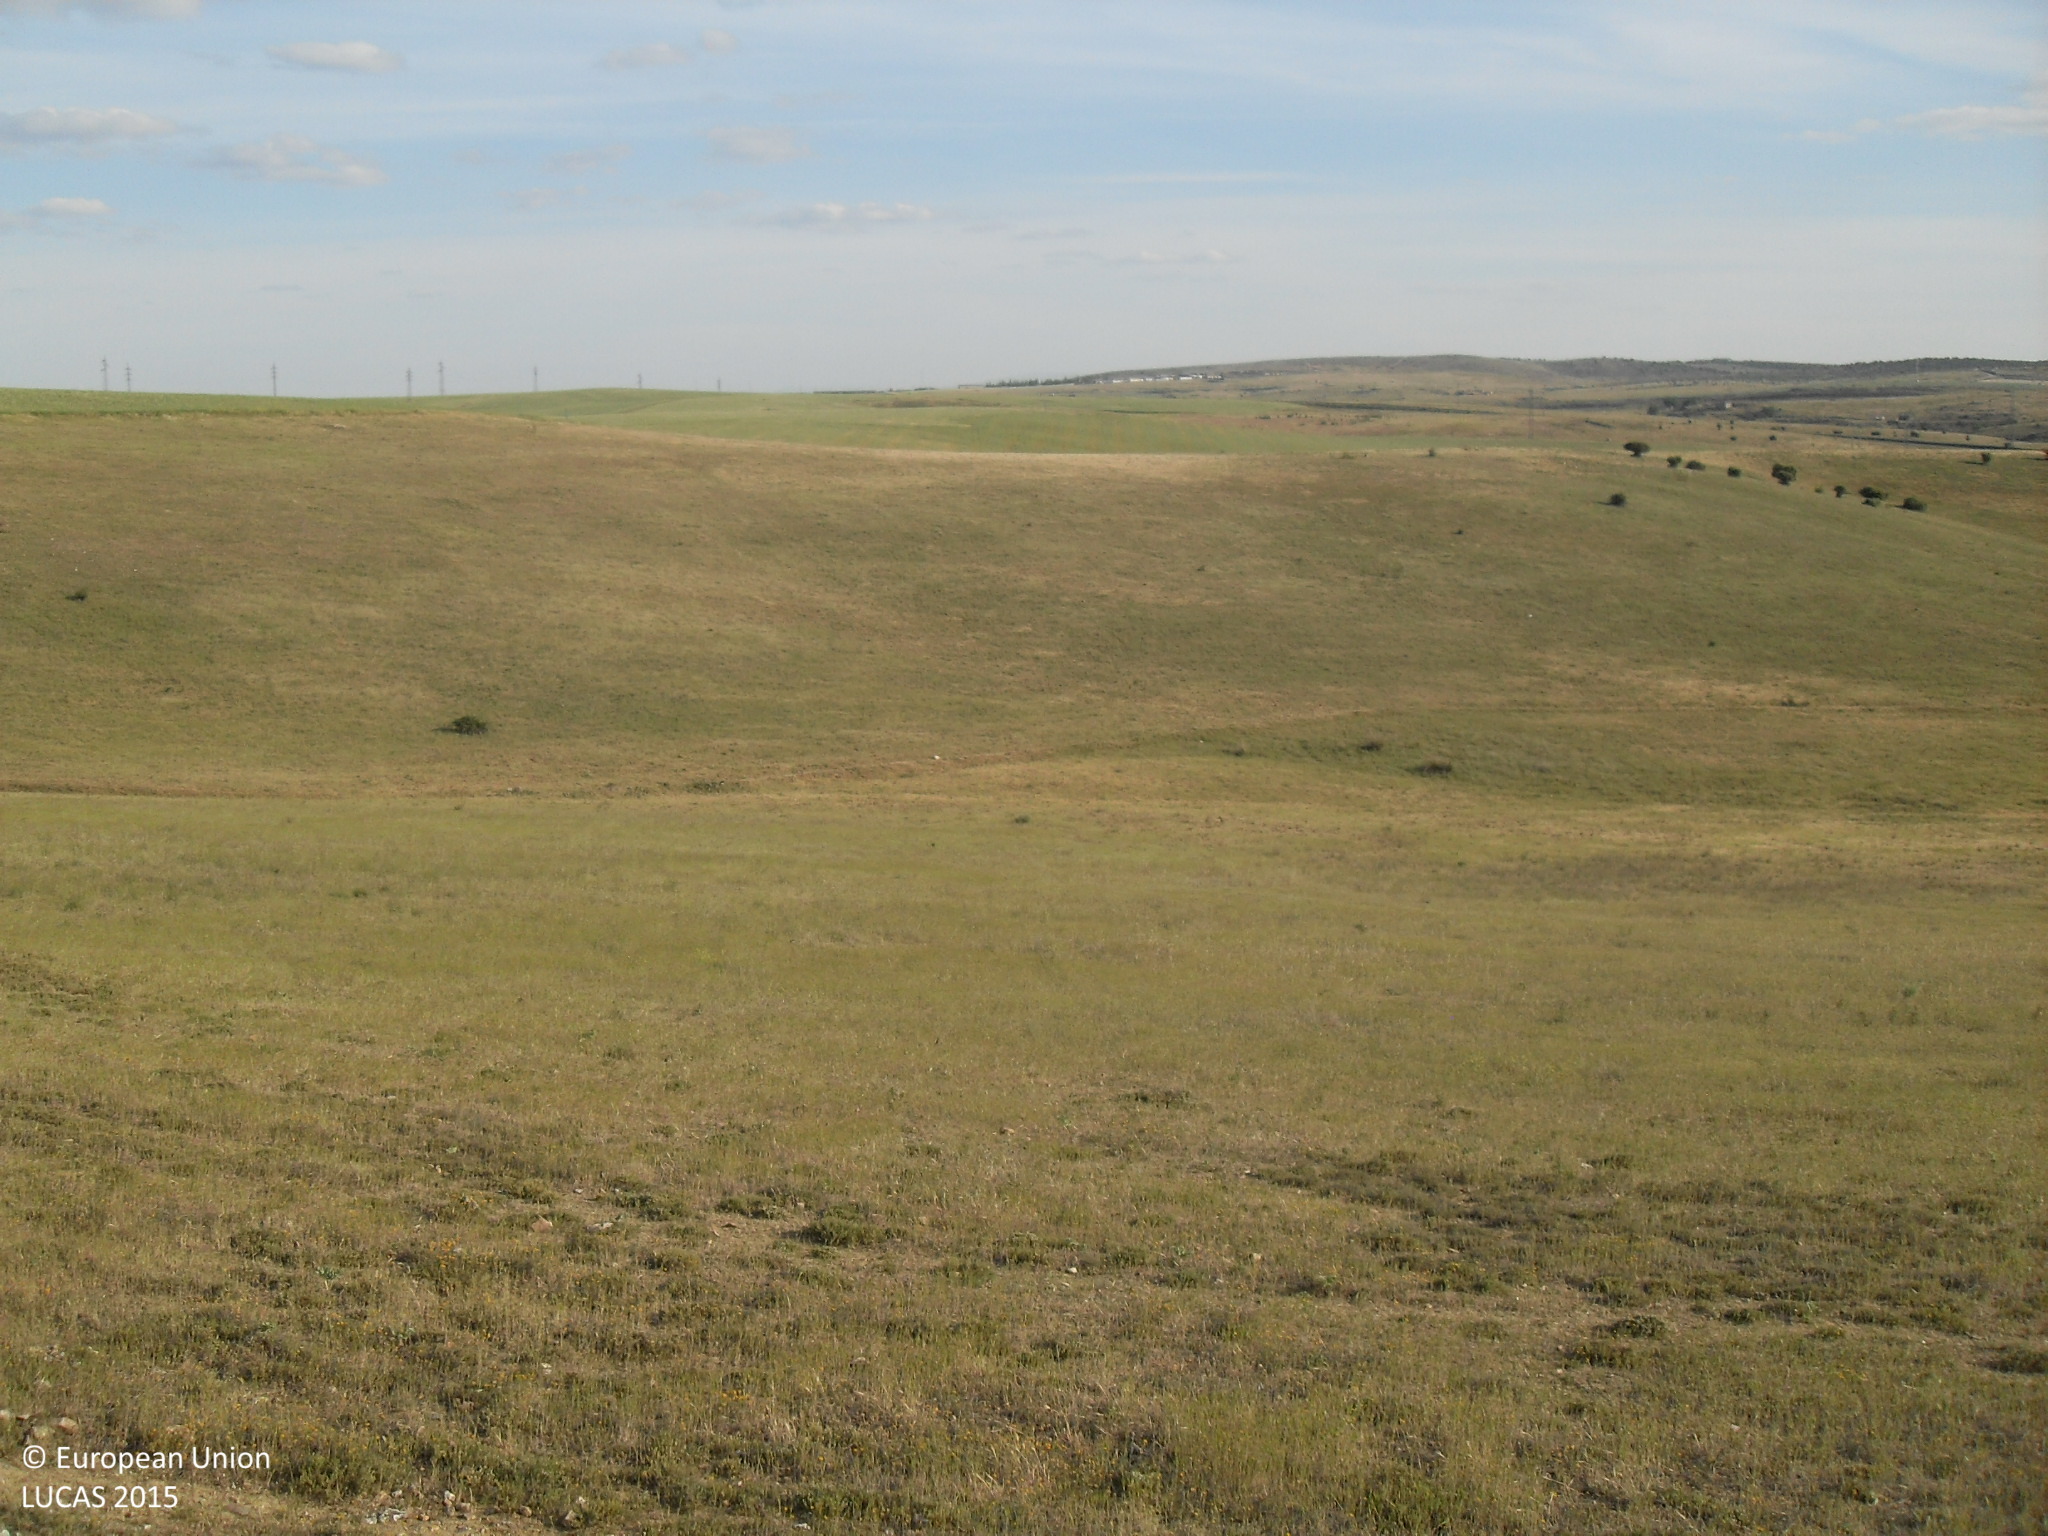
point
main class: Grassland
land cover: Grassland without tree/shrub cover
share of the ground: > 75 %
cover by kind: herbaceous plants 100 %
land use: Agriculture (excluding fallow land and kitchen gardens)
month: May
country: ES
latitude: 40.9788
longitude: -5.7066
